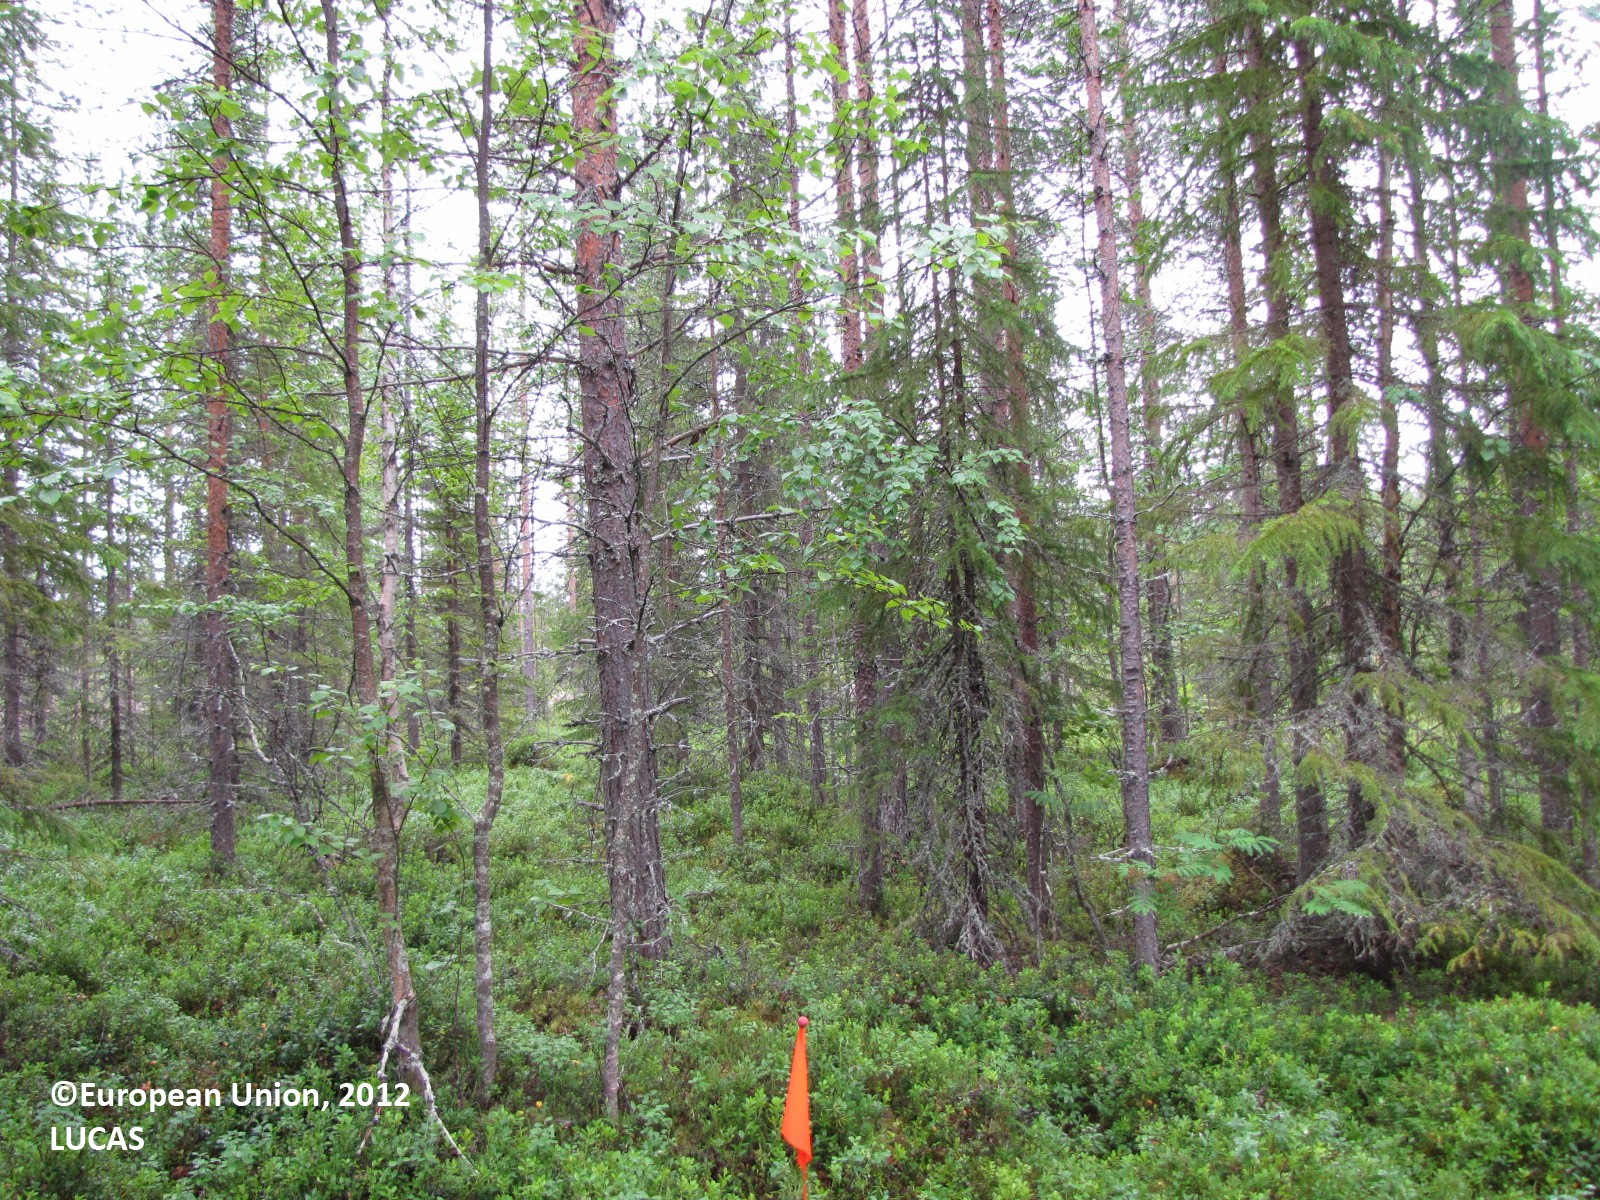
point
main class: Woodland
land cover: Other coniferous woodland
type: boreal forest
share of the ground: 50 - 75 %
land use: Forestry
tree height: > 5 m
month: July
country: FI
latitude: 66.6281
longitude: 24.8916
